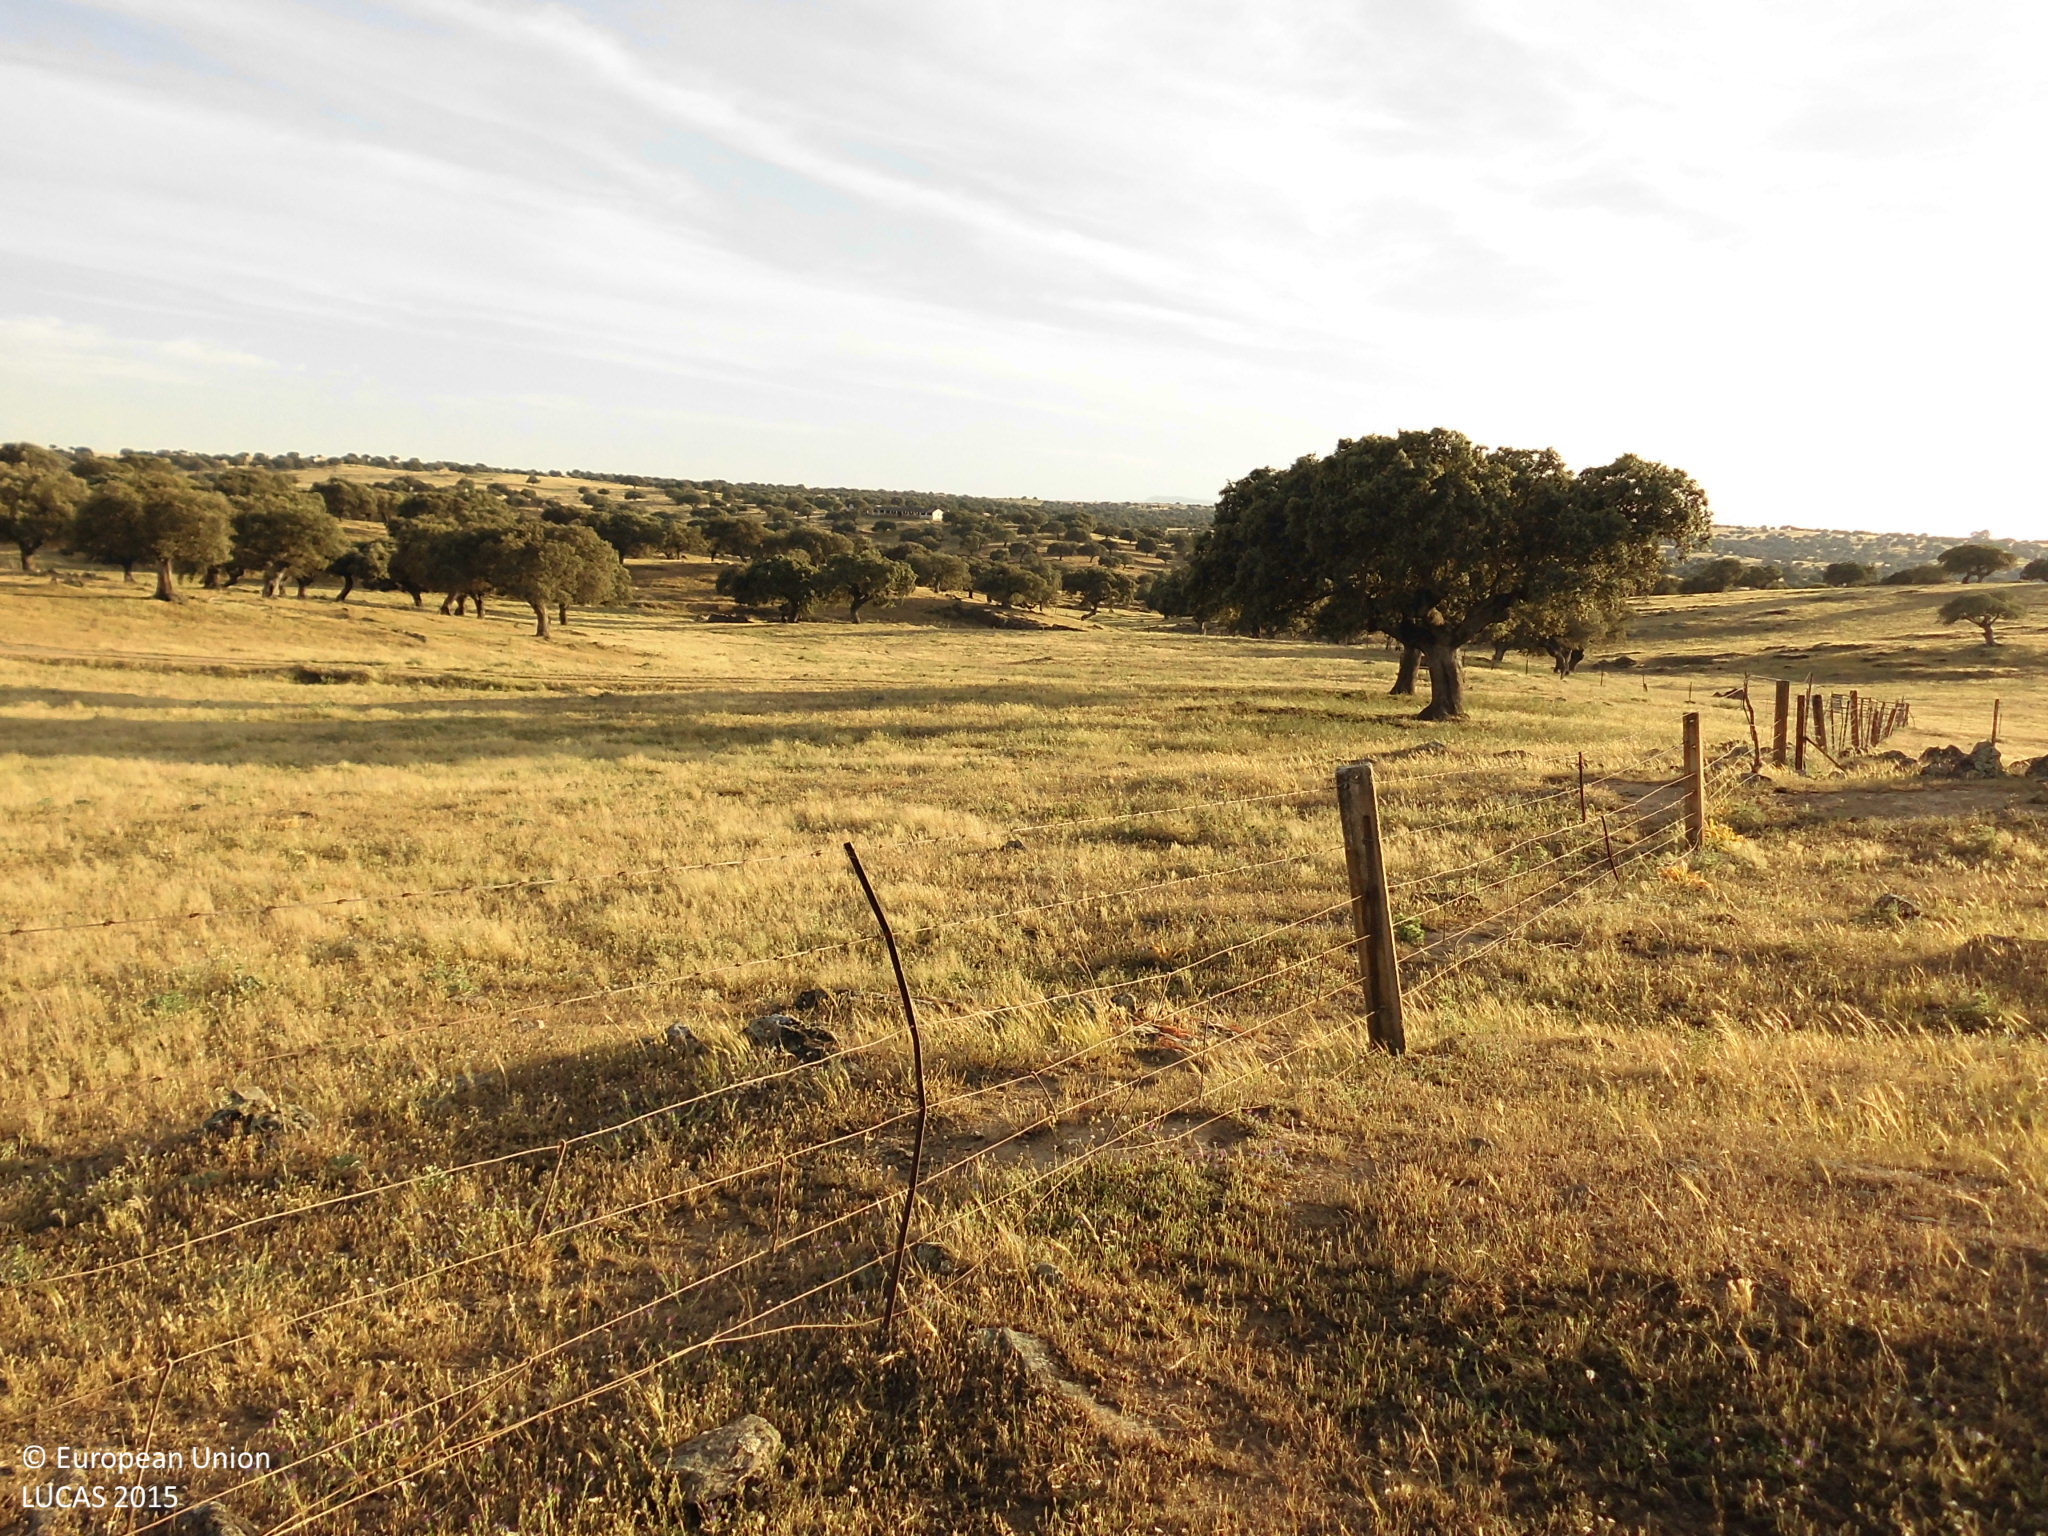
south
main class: Grassland
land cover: Grassland without tree/shrub cover
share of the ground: > 75 %
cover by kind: herbaceous plants 100 %
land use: Agriculture (excluding fallow land and kitchen gardens)
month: May
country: ES
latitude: 39.5907
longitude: -6.0984
